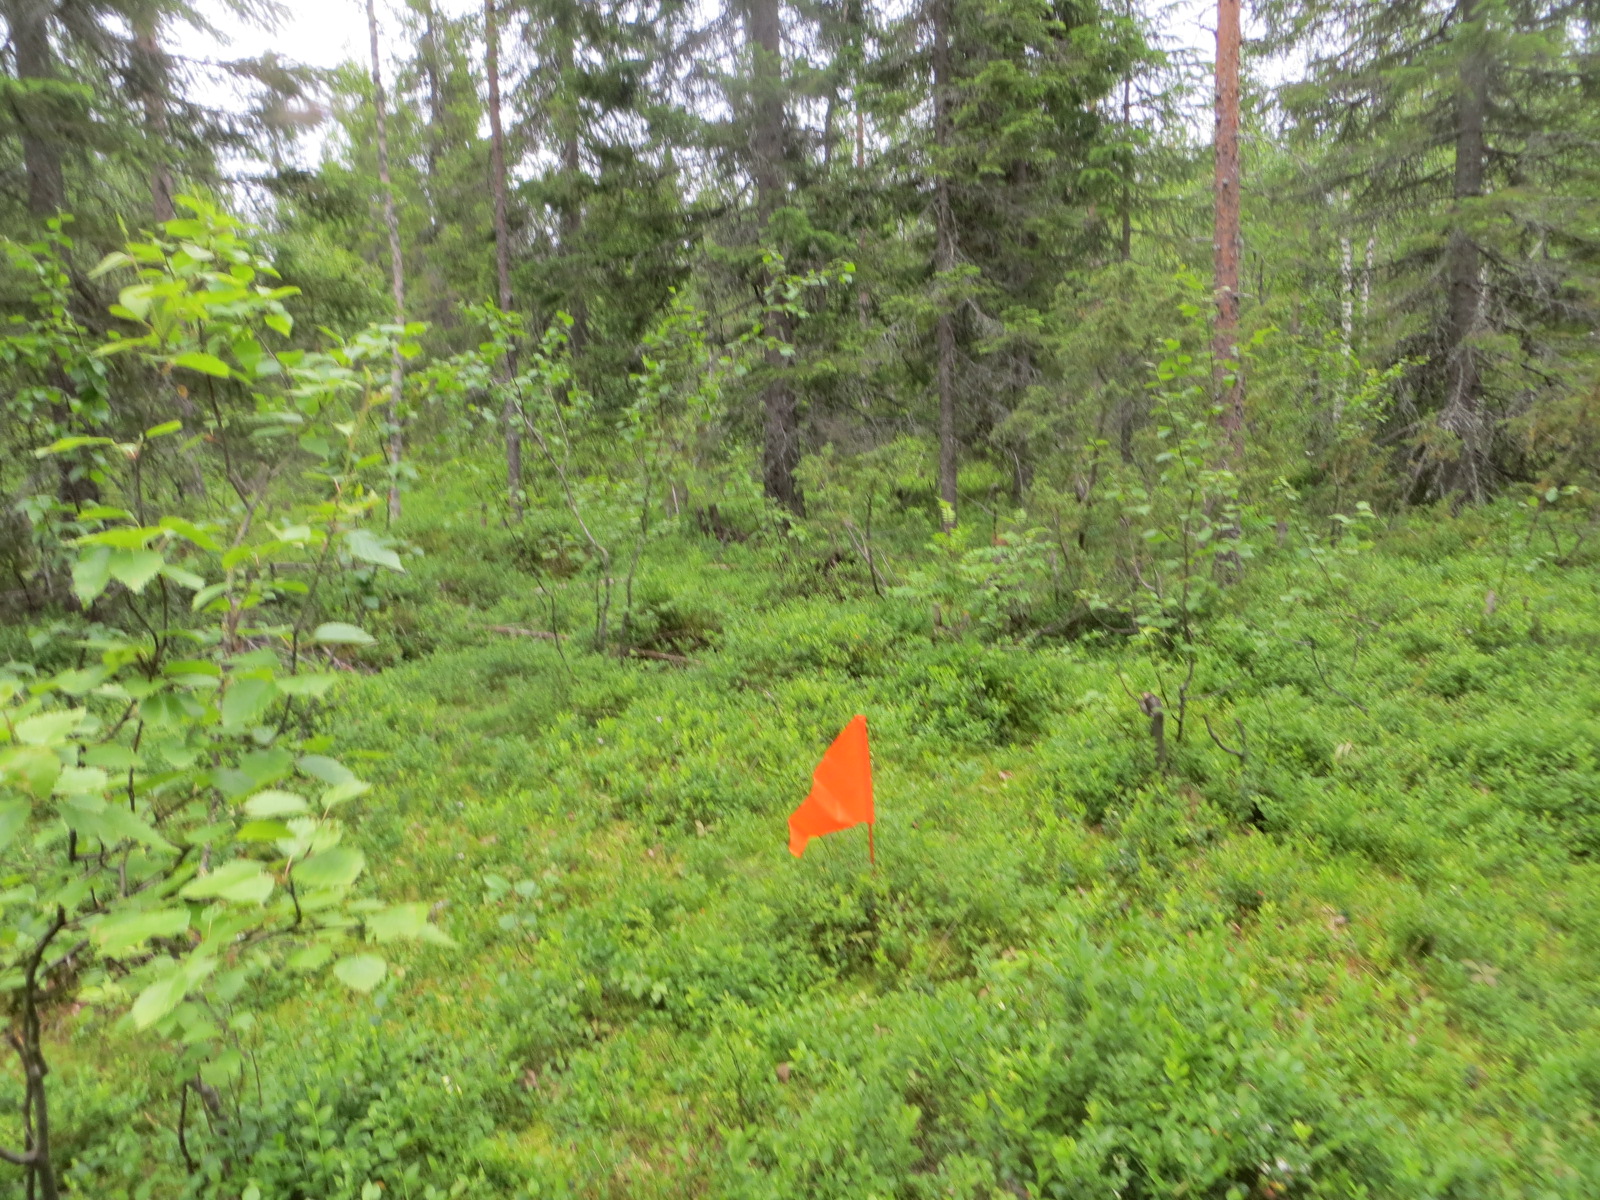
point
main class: Woodland
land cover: Other mixed woodland
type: boreal forest
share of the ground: 50 - 75 %
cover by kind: coniferous forest trees 40 %, broadleaved forest trees 30 %, shrubs 30 %
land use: Forestry
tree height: > 5 m
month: July
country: FI
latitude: 65.7554
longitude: 25.3258
